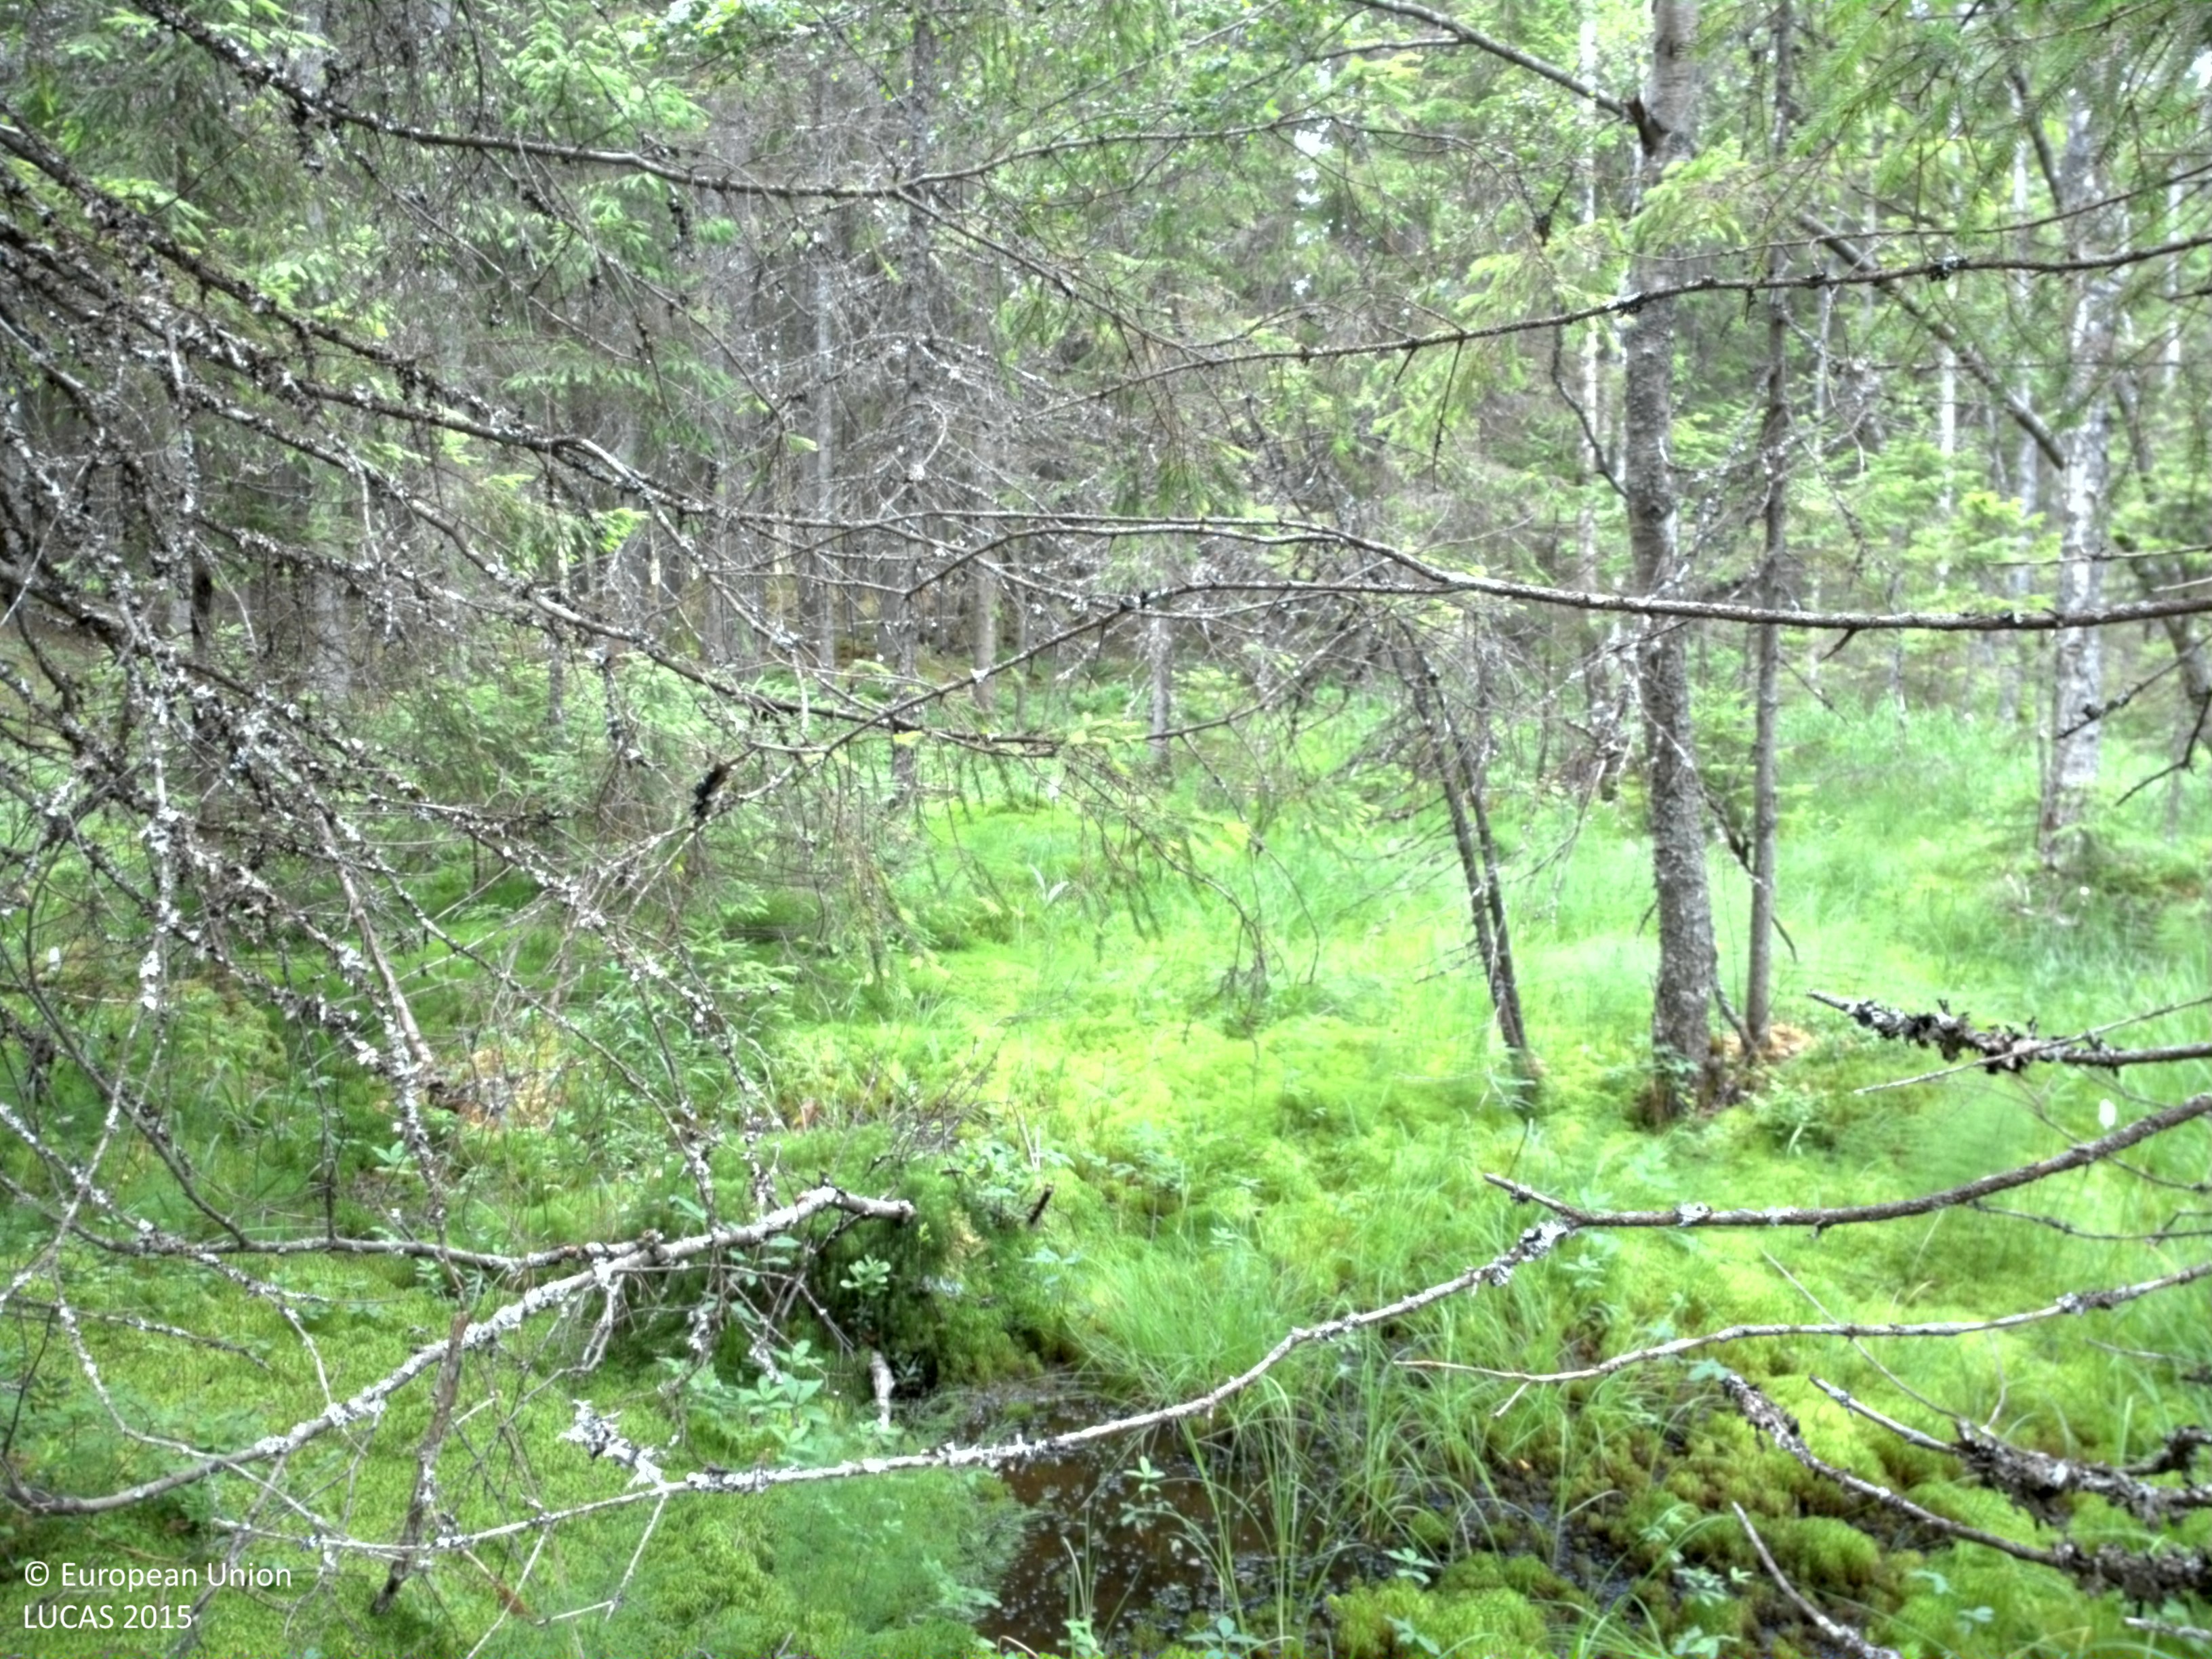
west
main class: Woodland
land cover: Spruce dominated mixed woodland
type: boreal forest
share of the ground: 25 - 50 %
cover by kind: lichens and mosses 40 %, coniferous forest trees 25 %, herbaceous plants 20 %, broadleaved forest trees 15 %
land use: Forestry
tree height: > 5 m
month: July
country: SE
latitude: 58.9639
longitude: 14.7744
